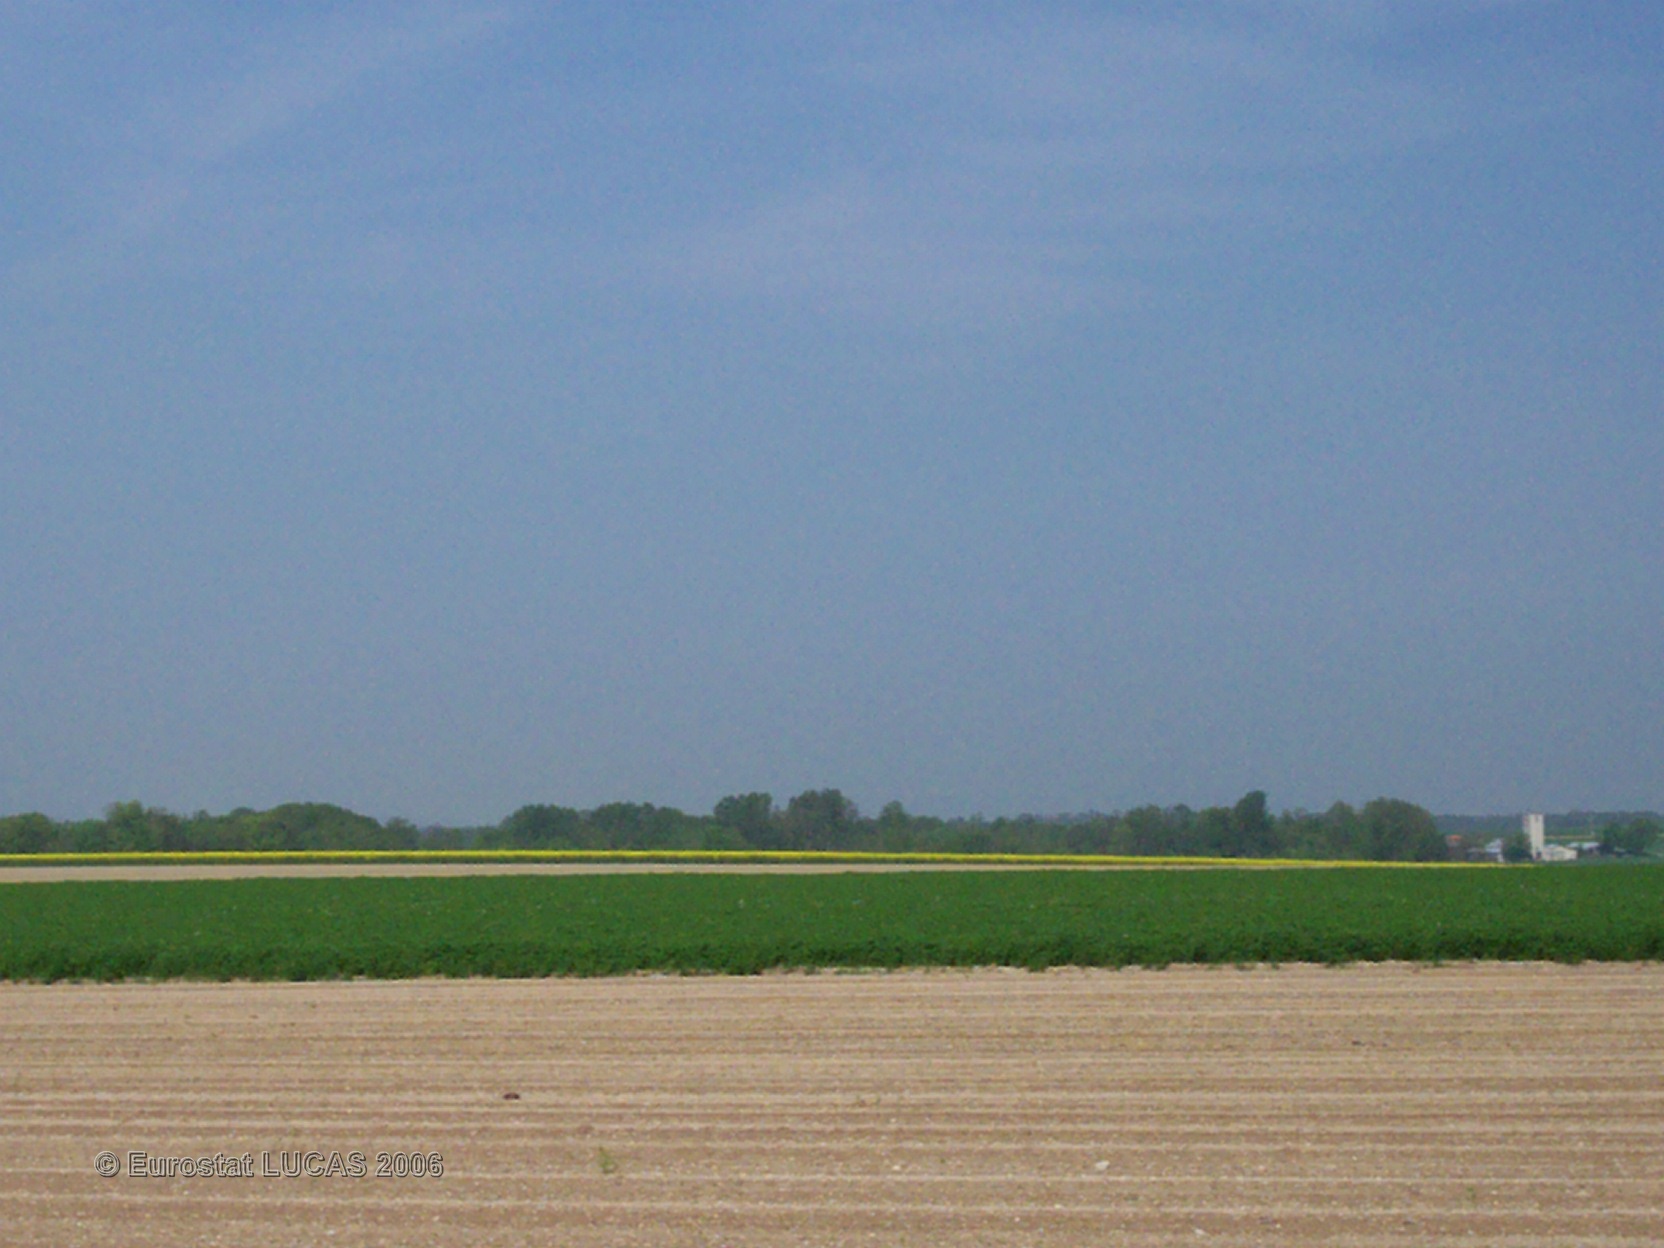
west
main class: Cropland
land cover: Sugar beet
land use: Agriculture (excluding fallow land and kitchen gardens)
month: May
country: FR
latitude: 49.0578
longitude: 4.4542
